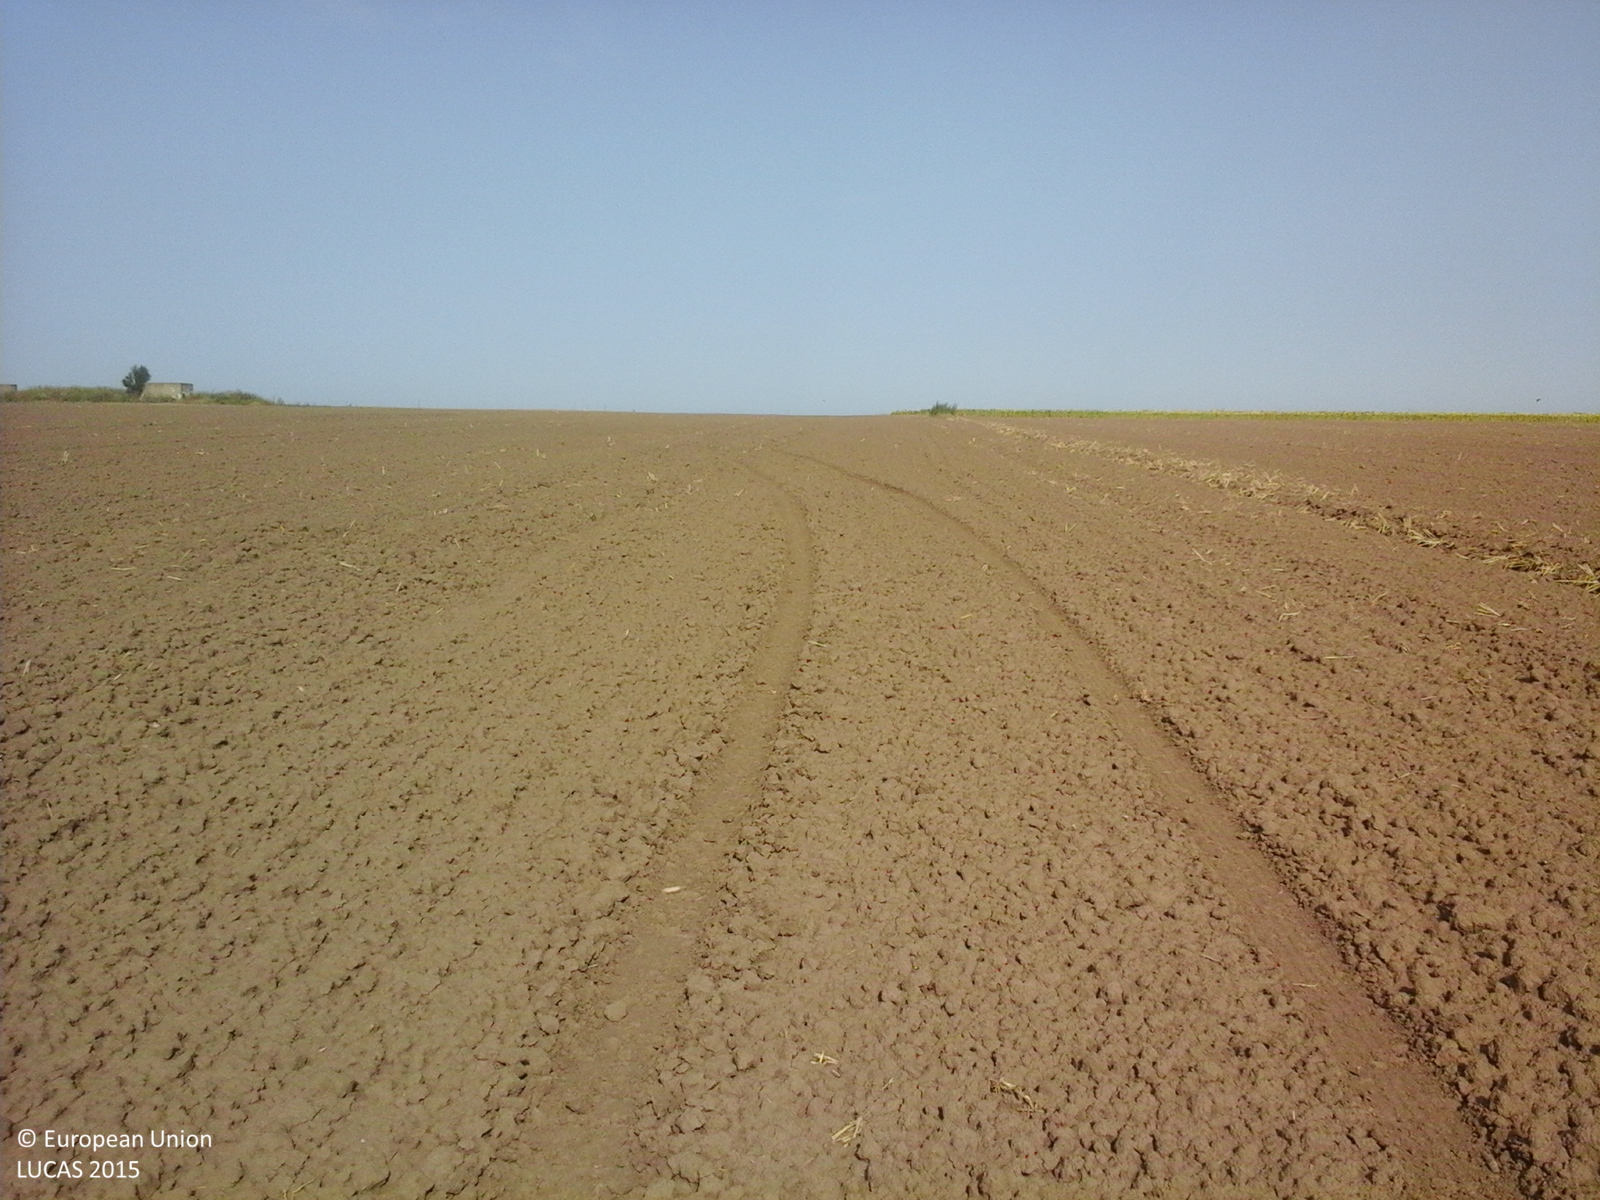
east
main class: Cropland
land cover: Common wheat
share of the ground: < 10 %
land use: Agriculture (excluding fallow land and kitchen gardens)
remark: Harvested field
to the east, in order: Common wheat; Tracks; Maize
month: August
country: RO
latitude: 44.0450
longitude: 28.3470
